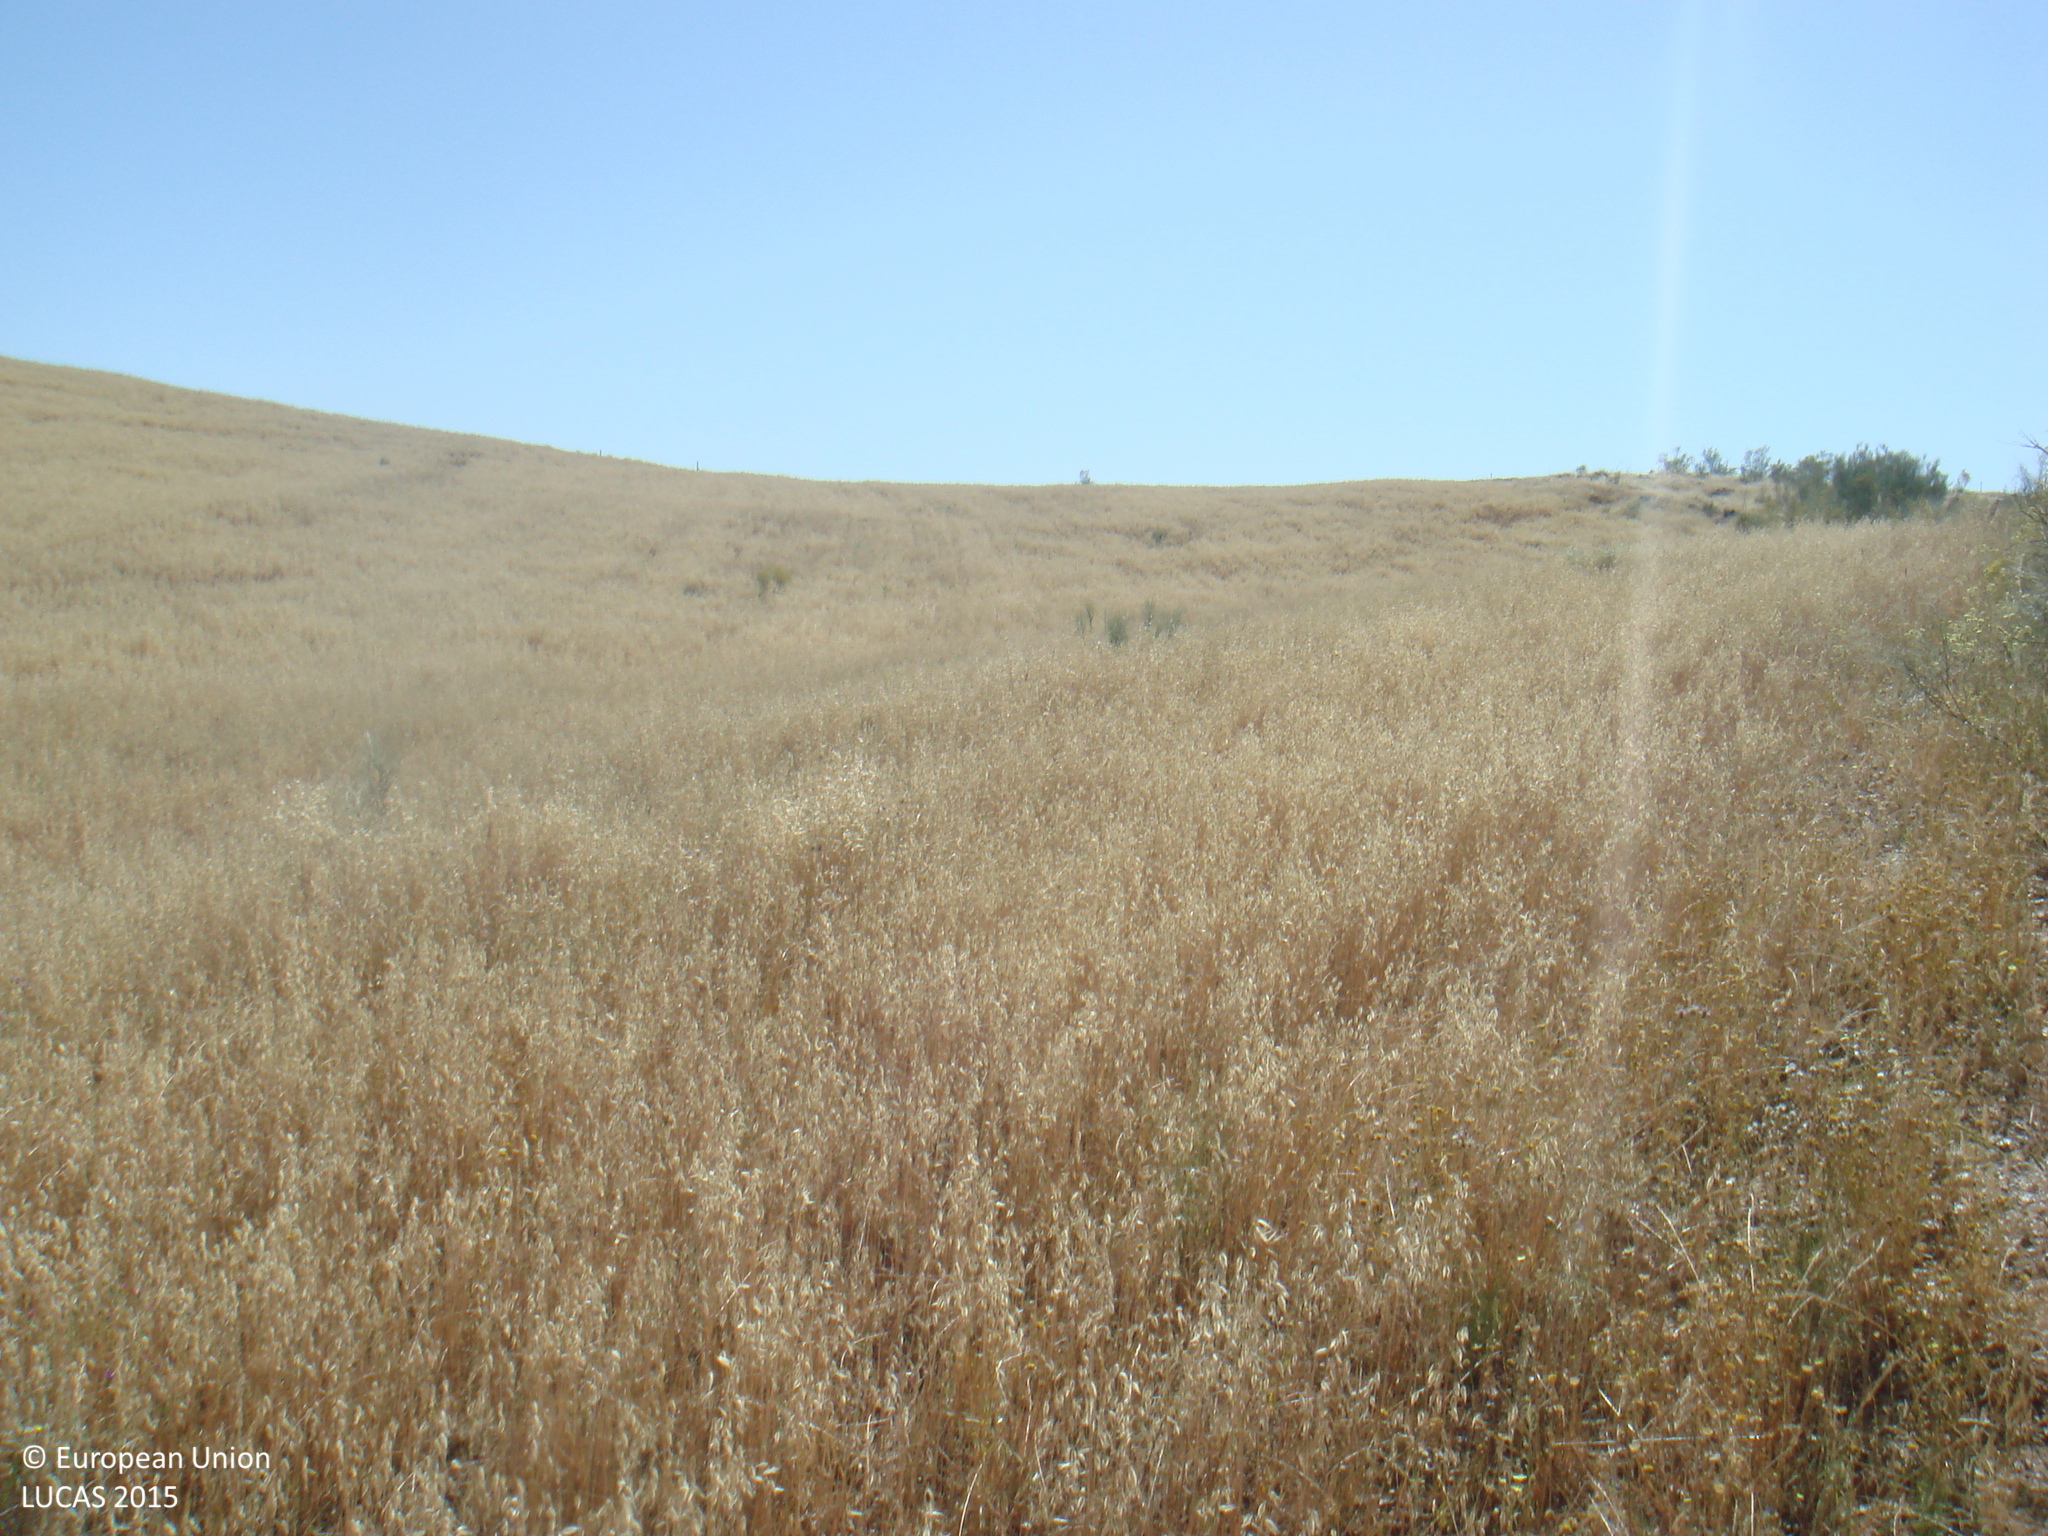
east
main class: Cropland
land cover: Oats
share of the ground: 50 - 75 %
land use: Agriculture (excluding fallow land and kitchen gardens)
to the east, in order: Oats; Grass margins; Fences; Shrubland without tree cover; Spontaneously vegetated surfaces; Fences; Spontaneously vegetated surfaces
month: May
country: ES
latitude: 38.6400
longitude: -5.1630
